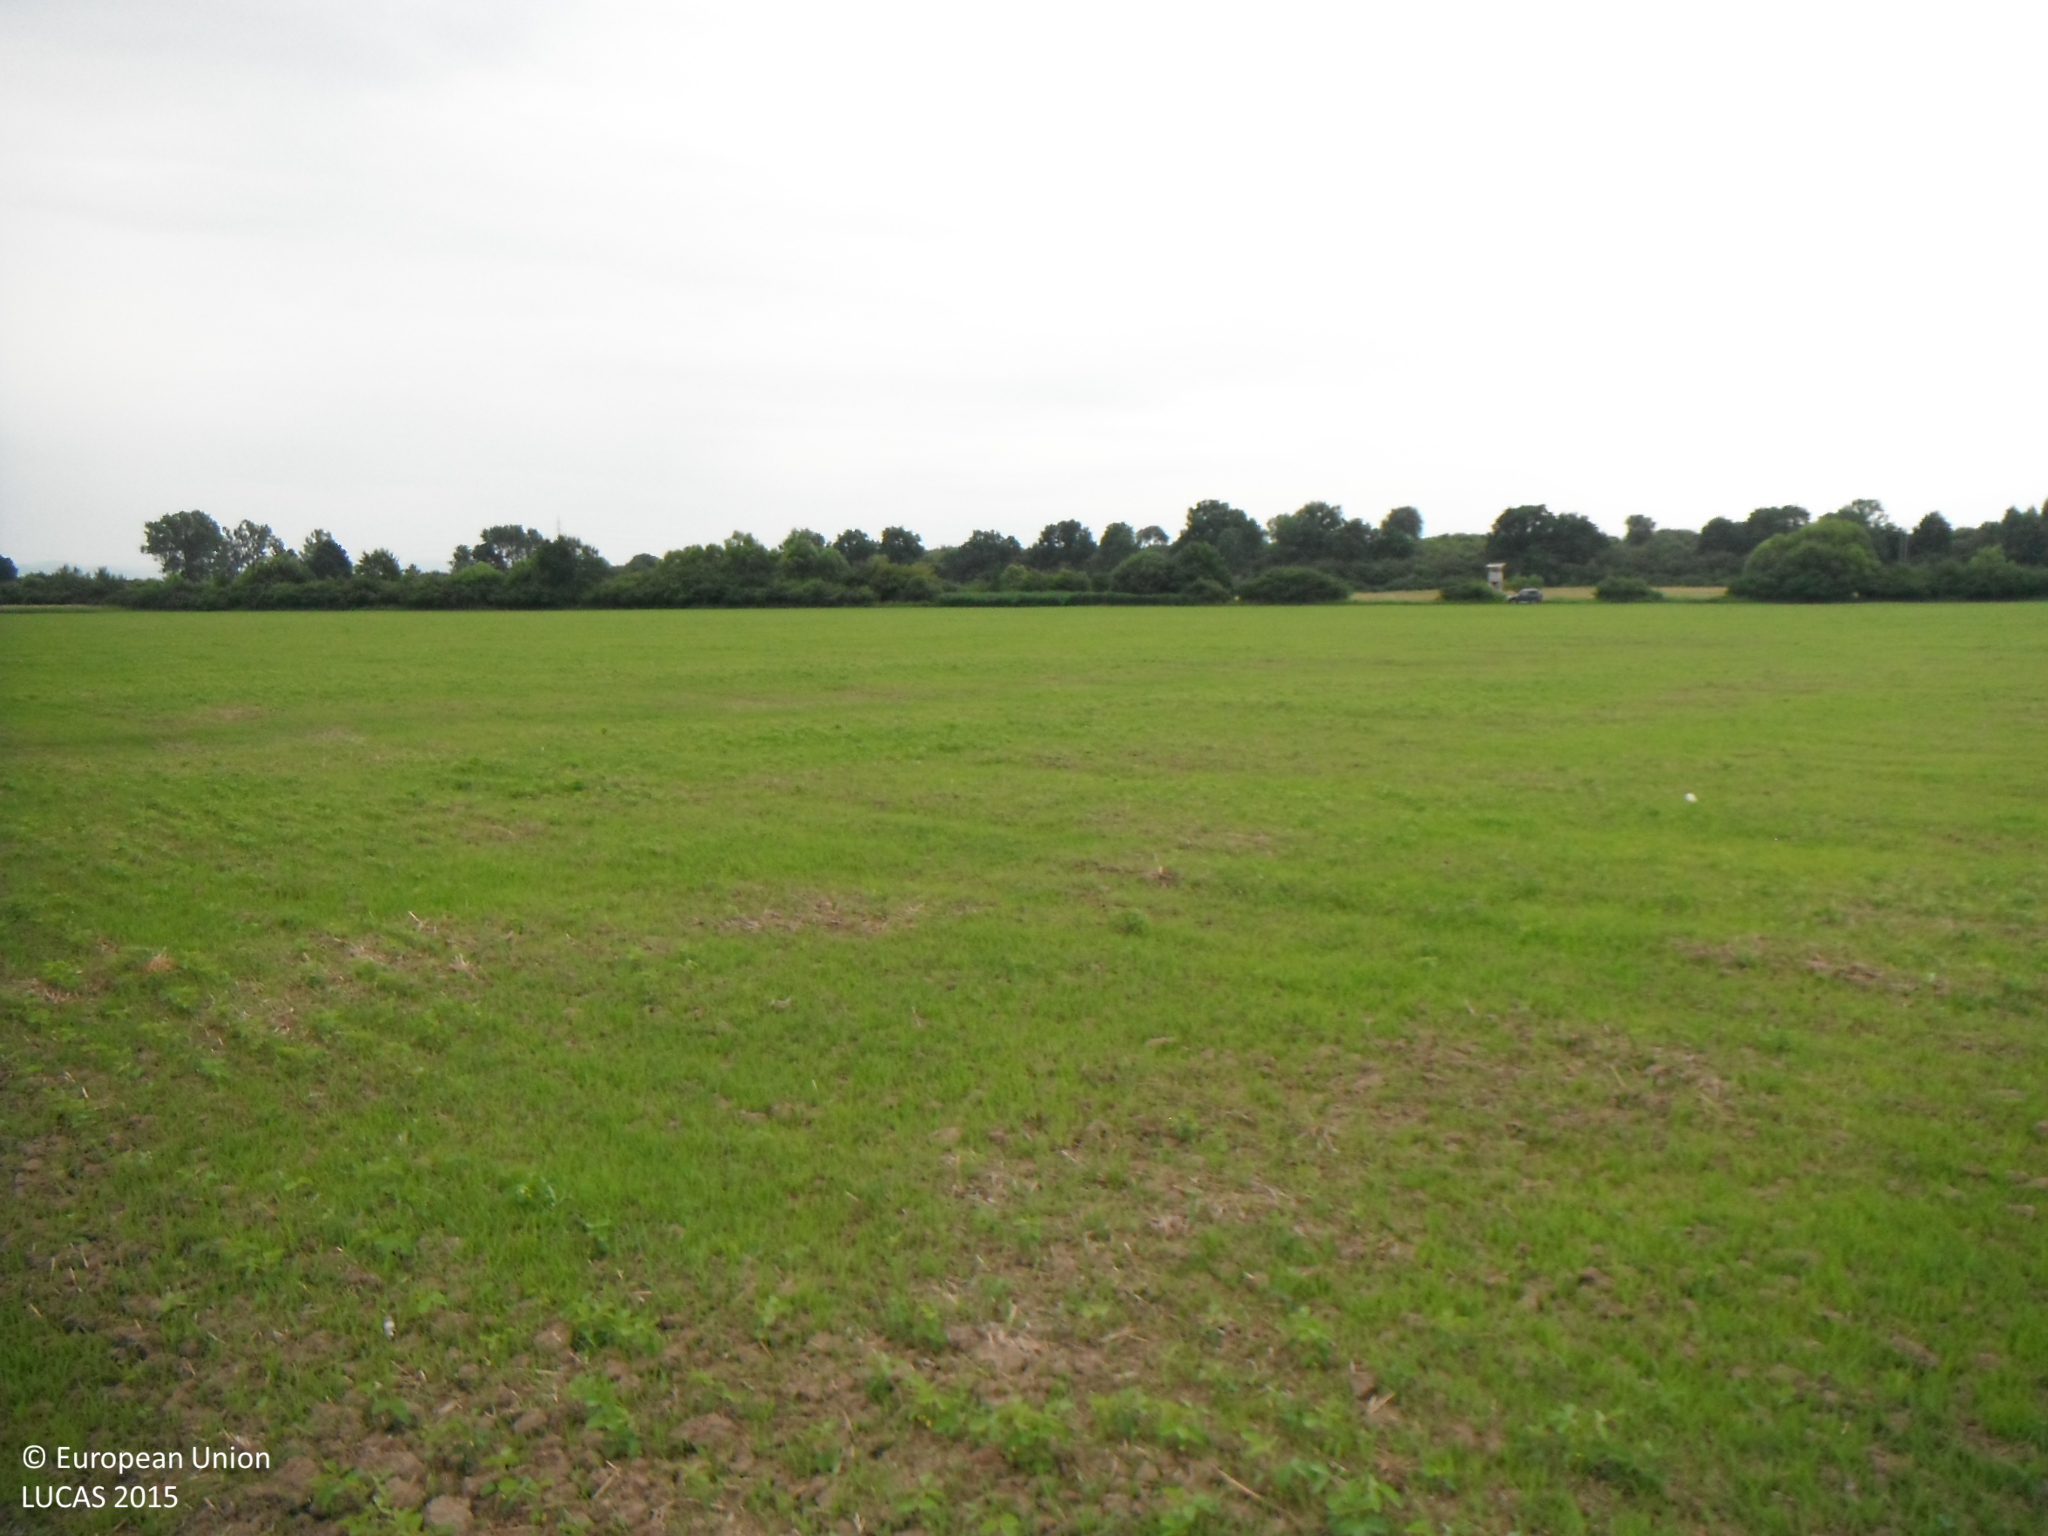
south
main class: Cropland
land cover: Soya
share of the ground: 25 - 50 %
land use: Agriculture (excluding fallow land and kitchen gardens)
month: June
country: SK
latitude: 48.3718
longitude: 19.7329
